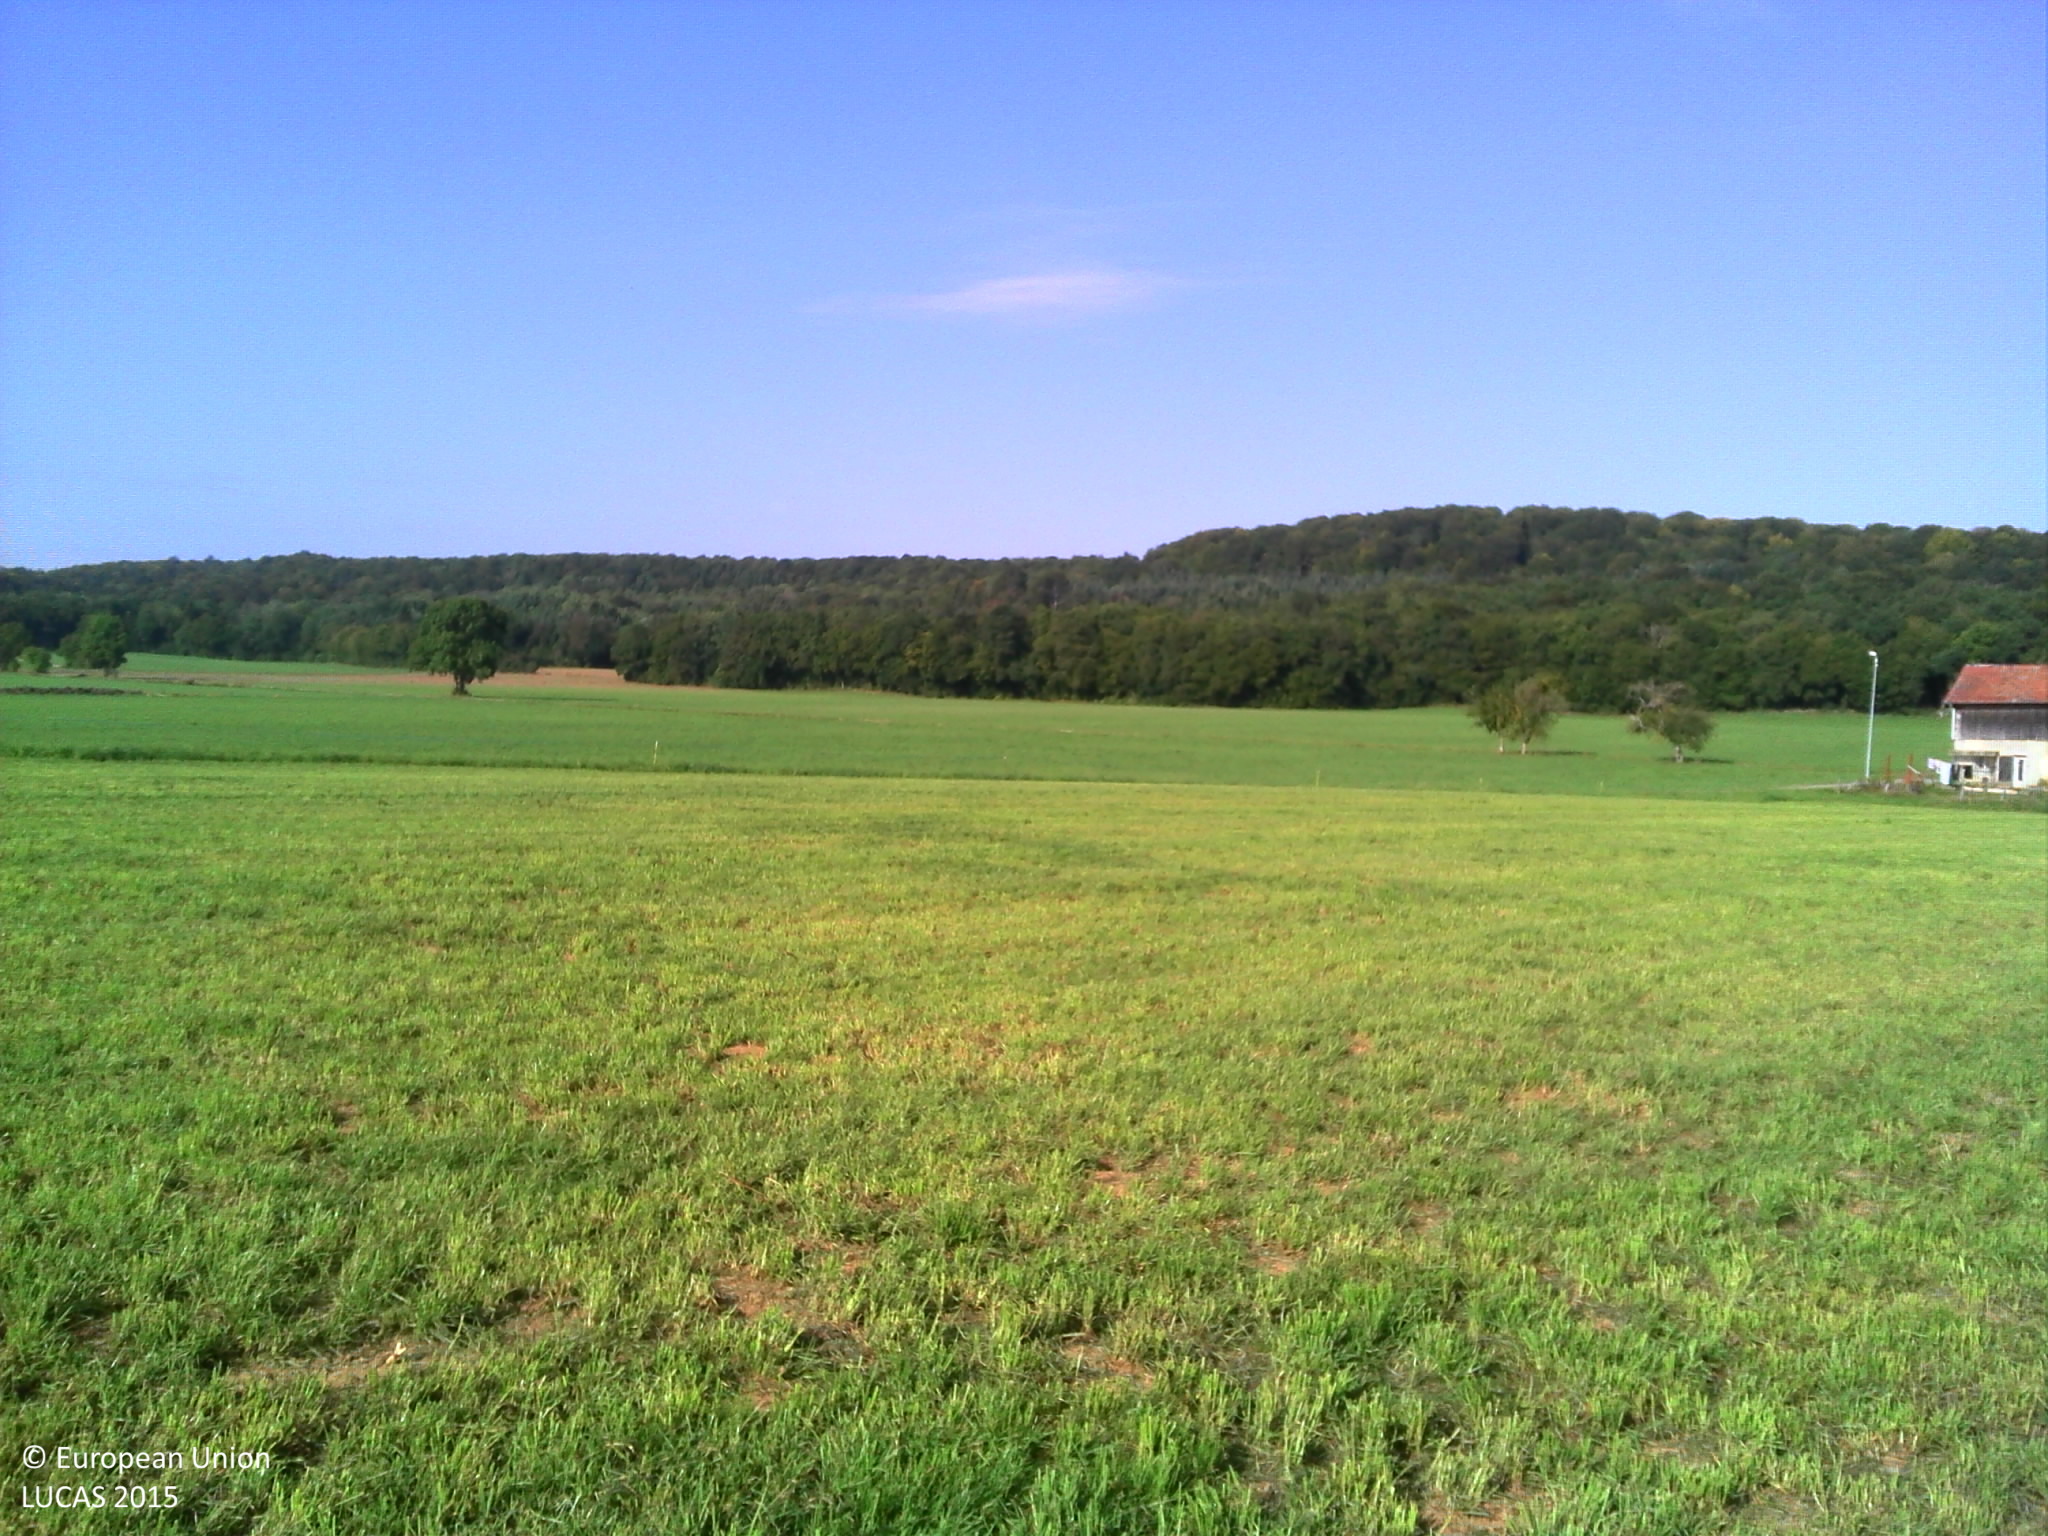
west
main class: Grassland
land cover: Grassland without tree/shrub cover
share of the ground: > 75 %
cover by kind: herbaceous plants 100 %
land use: Agriculture (excluding fallow land and kitchen gardens)
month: September
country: FR
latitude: 47.2261
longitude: 6.3436
